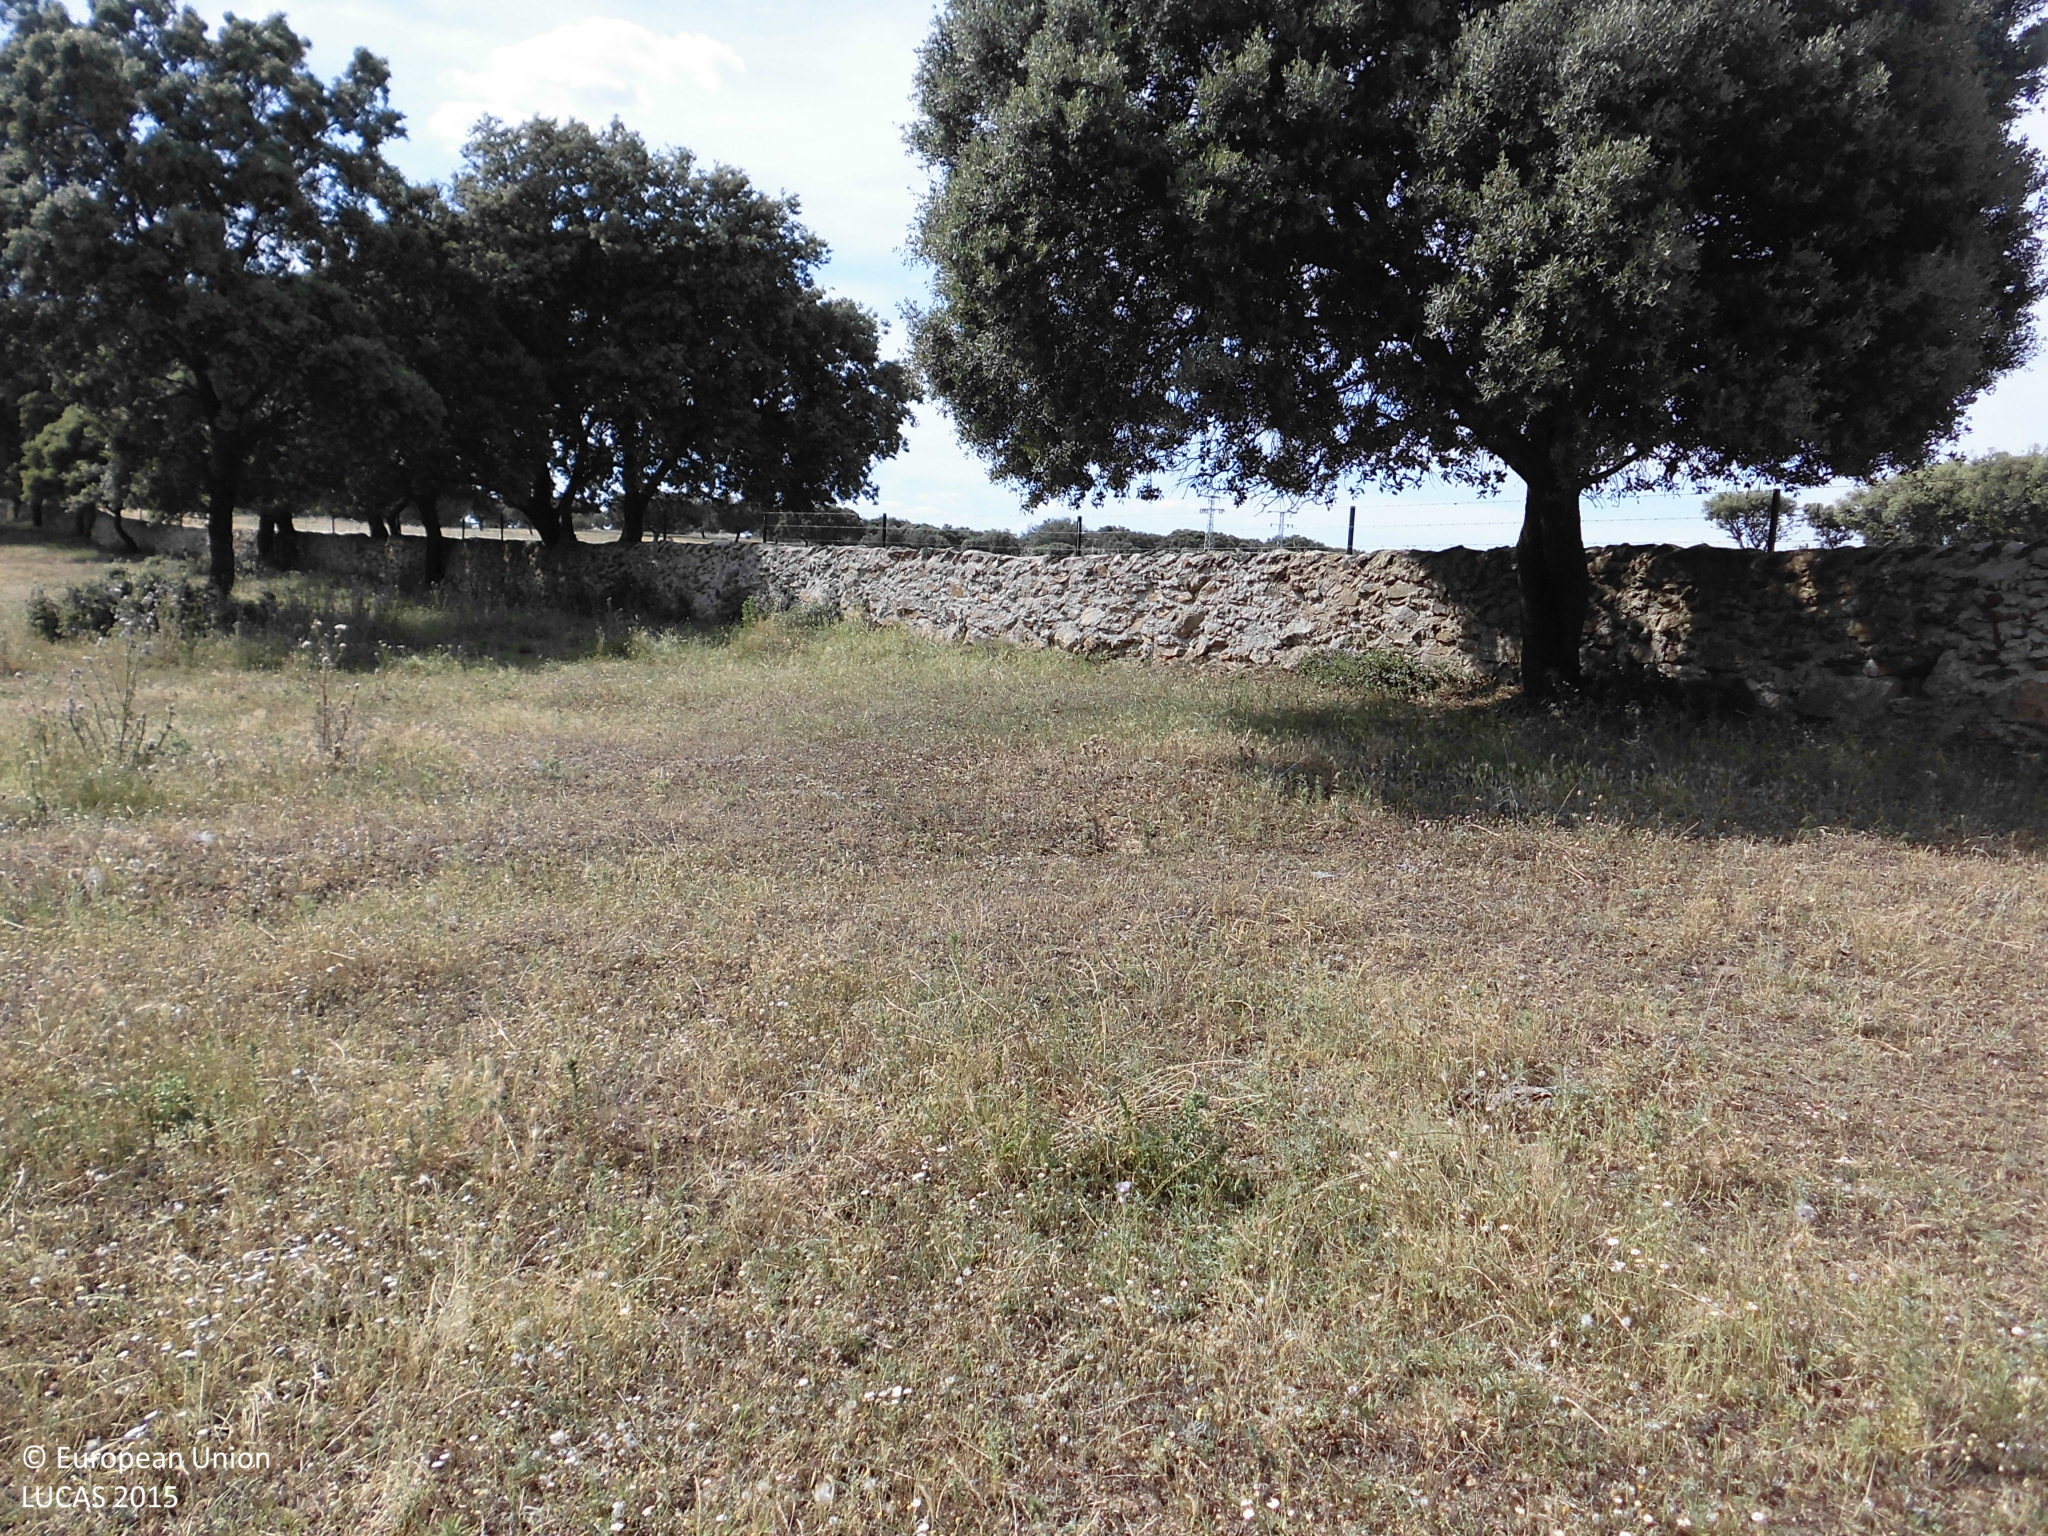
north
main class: Woodland
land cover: Broadleaved woodland
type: broadleaved evergreen forest
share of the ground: 10 - 25 %
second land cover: Grassland without tree/shrub cover
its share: > 75 %
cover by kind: herbaceous plants 75 %, broadleaved forest trees 25 %
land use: Forestry
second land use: Agriculture (excluding fallow land and kitchen gardens)
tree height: > 5 m
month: May
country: ES
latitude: 39.6131
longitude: -6.7224
